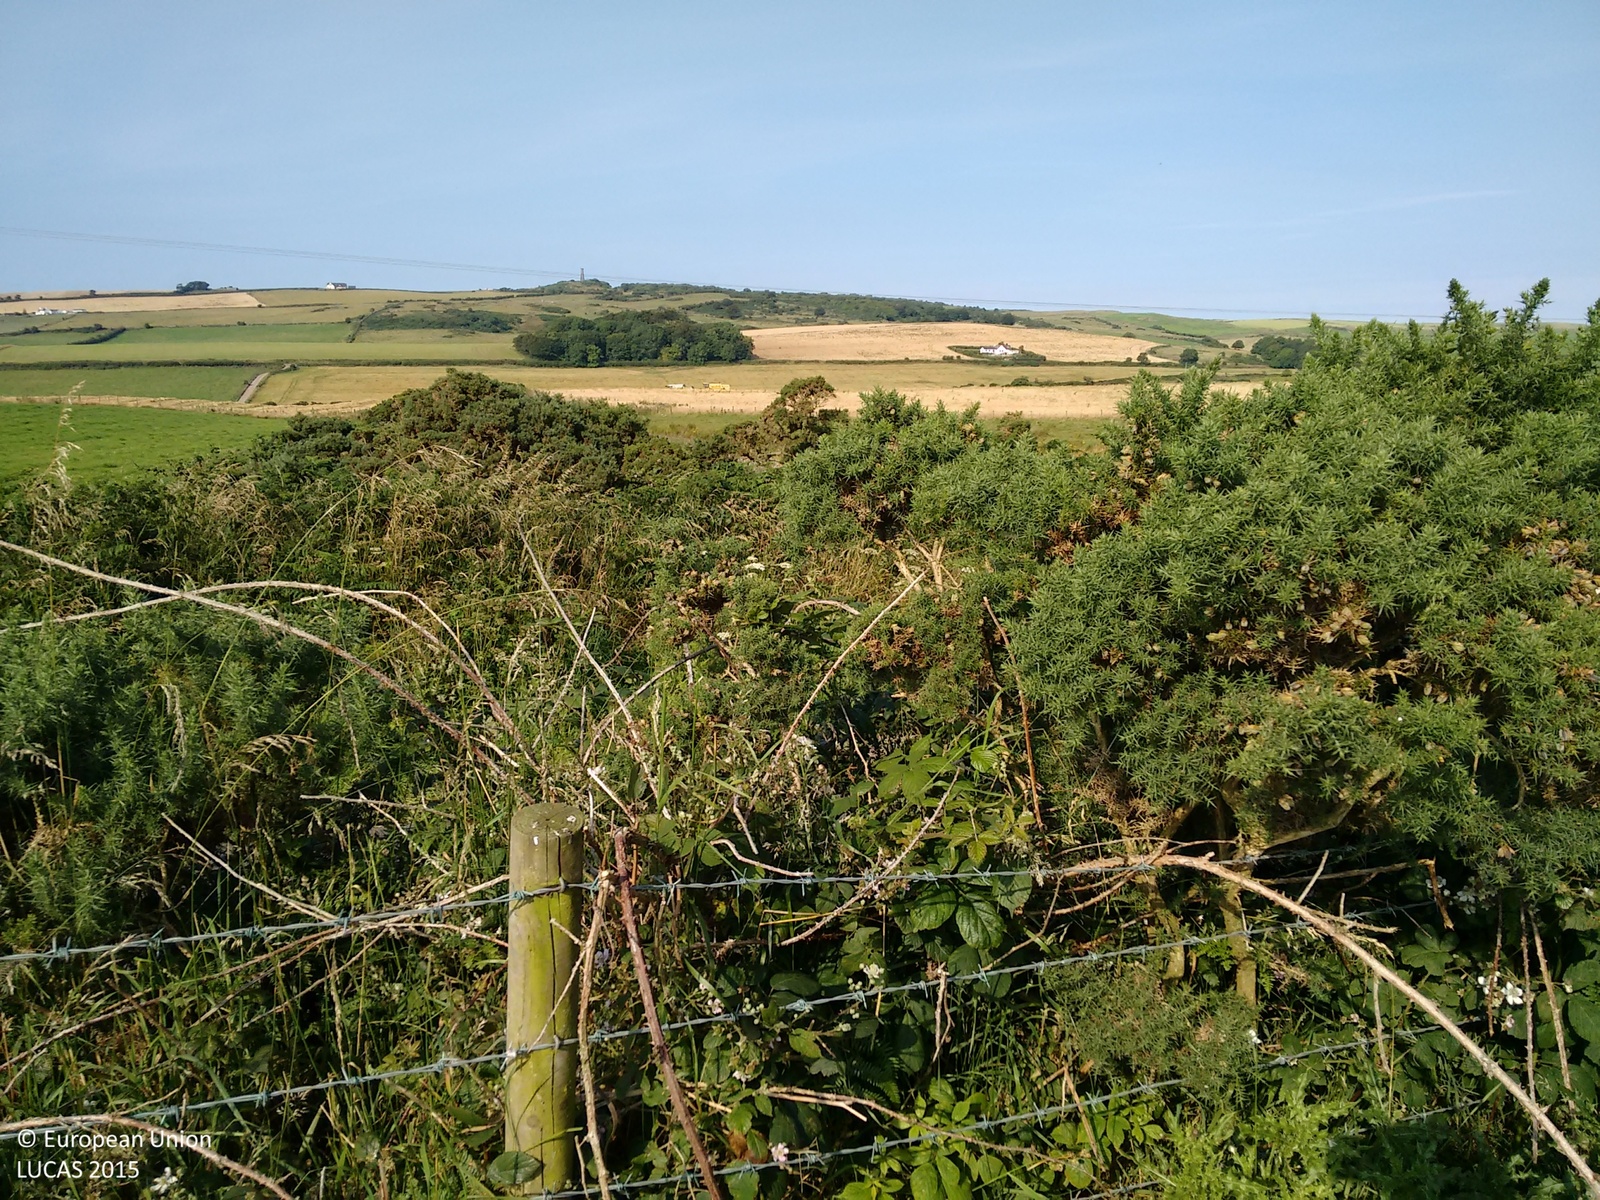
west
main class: Grassland
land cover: Grassland with sparse tree/shrub cover
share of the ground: > 75 %
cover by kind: herbaceous plants 85 %, shrubs 10 %, broadleaved forest trees 5 %
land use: Agriculture (excluding fallow land and kitchen gardens)
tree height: < 5 m
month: August
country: GB
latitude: 54.9402
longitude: -5.0855
